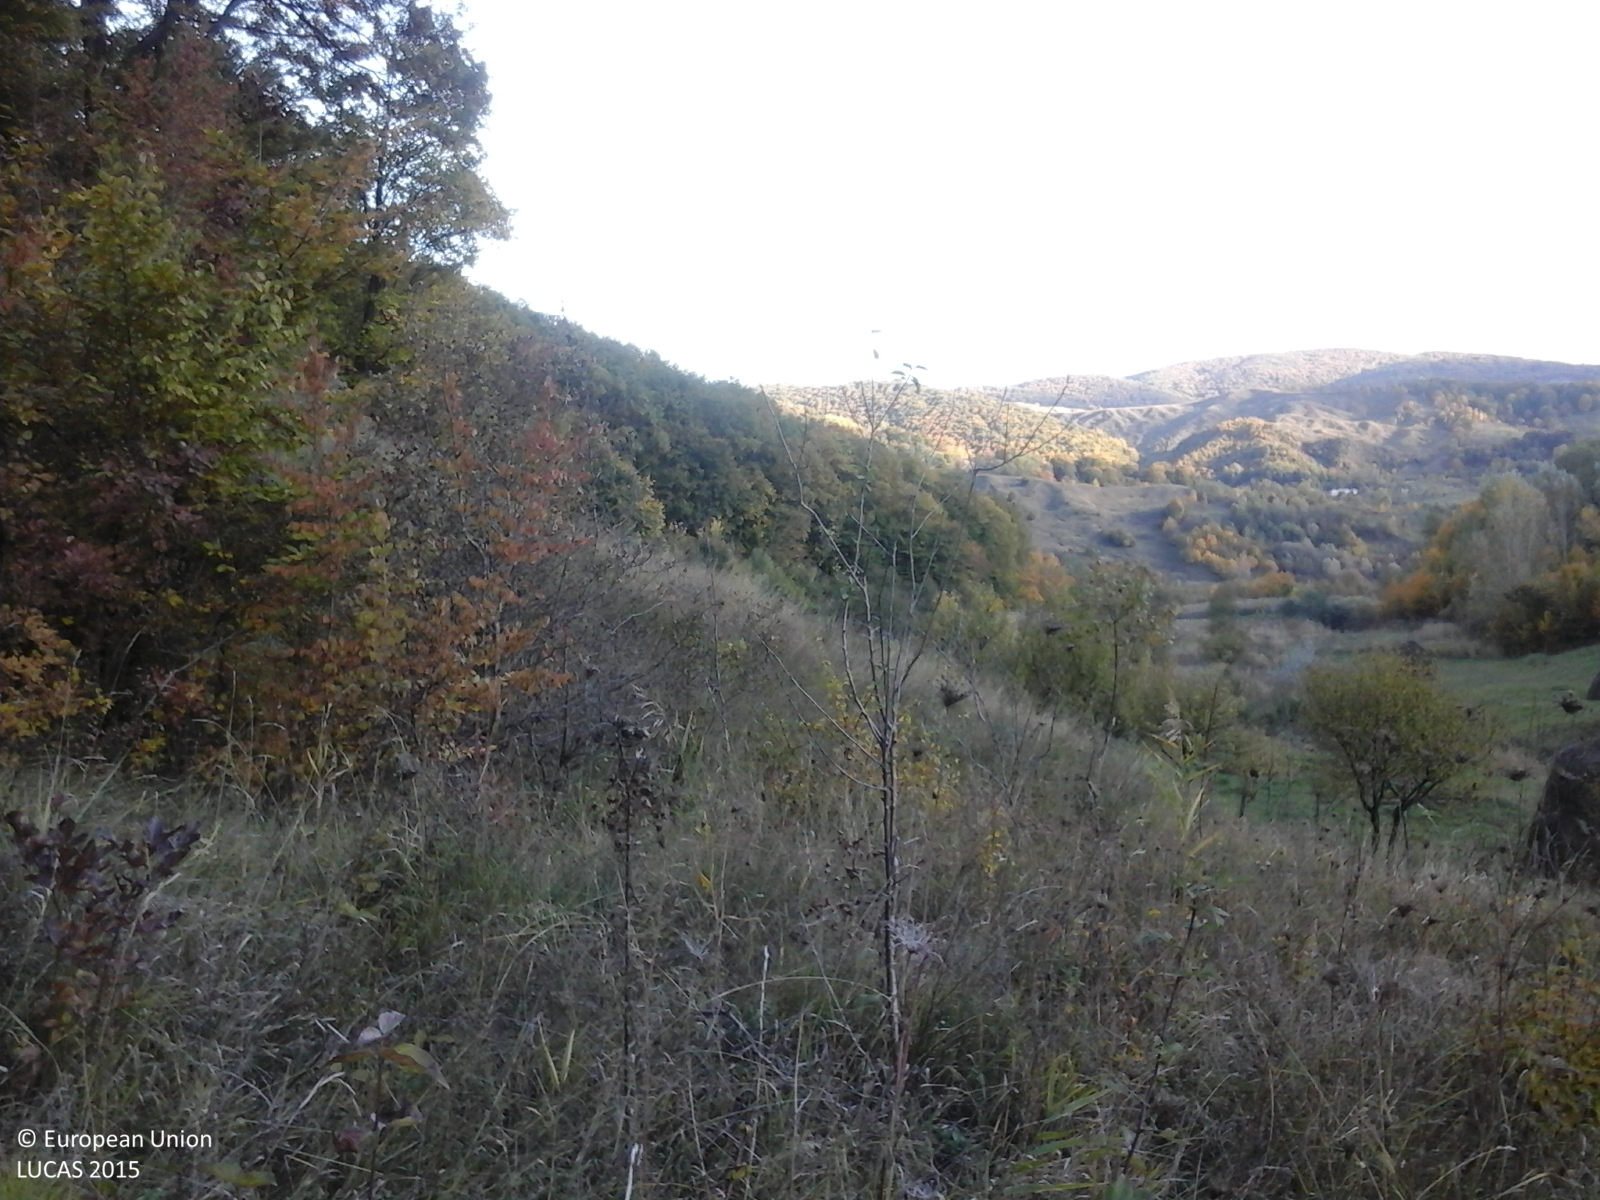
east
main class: Woodland
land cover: Broadleaved woodland
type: acidophilous oak and oak-birch forest
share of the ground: > 75 %
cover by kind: broadleaved forest trees 100 %
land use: Forestry
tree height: > 5 m
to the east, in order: Broadleaved woodland; Grassland with sparse tree/shrub cover; Tracks; Grassland with sparse tree/shrub cover; Broadleaved woodland
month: October
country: RO
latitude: 45.1967
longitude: 26.3227
